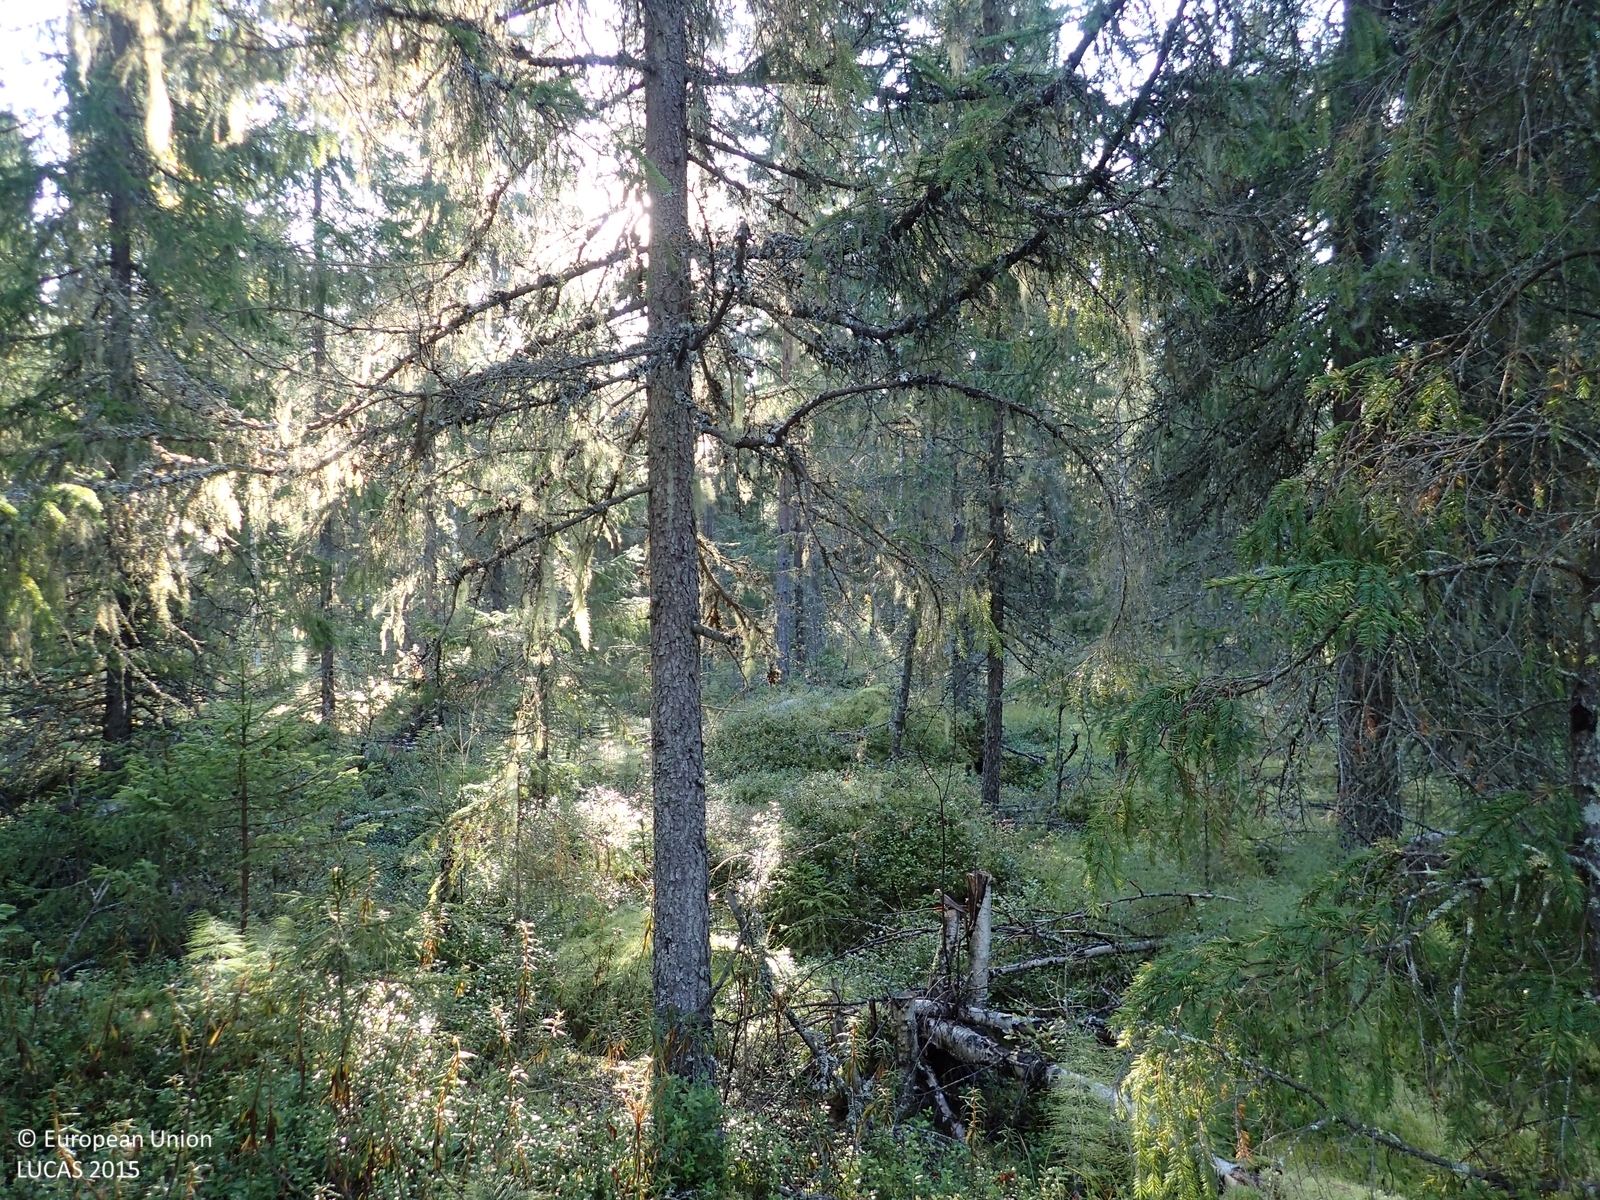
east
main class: Woodland
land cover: Spruce dominated coniferous woodland
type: boreal forest
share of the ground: > 75 %
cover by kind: coniferous forest trees 70 %, shrubs 15 %, broadleaved forest trees 5 %, herbaceous plants 5 %, lichens and mosses 5 %
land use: Forestry
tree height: > 5 m
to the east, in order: Spruce dominated coniferous woodland; Ditches and canals; Spruce dominated coniferous woodland; Ditches and canals; Spruce dominated coniferous woodland; Pine dominated coniferous woodland; Pine dominated mixed woodland
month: September
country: FI
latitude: 63.0887
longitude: 25.3715
